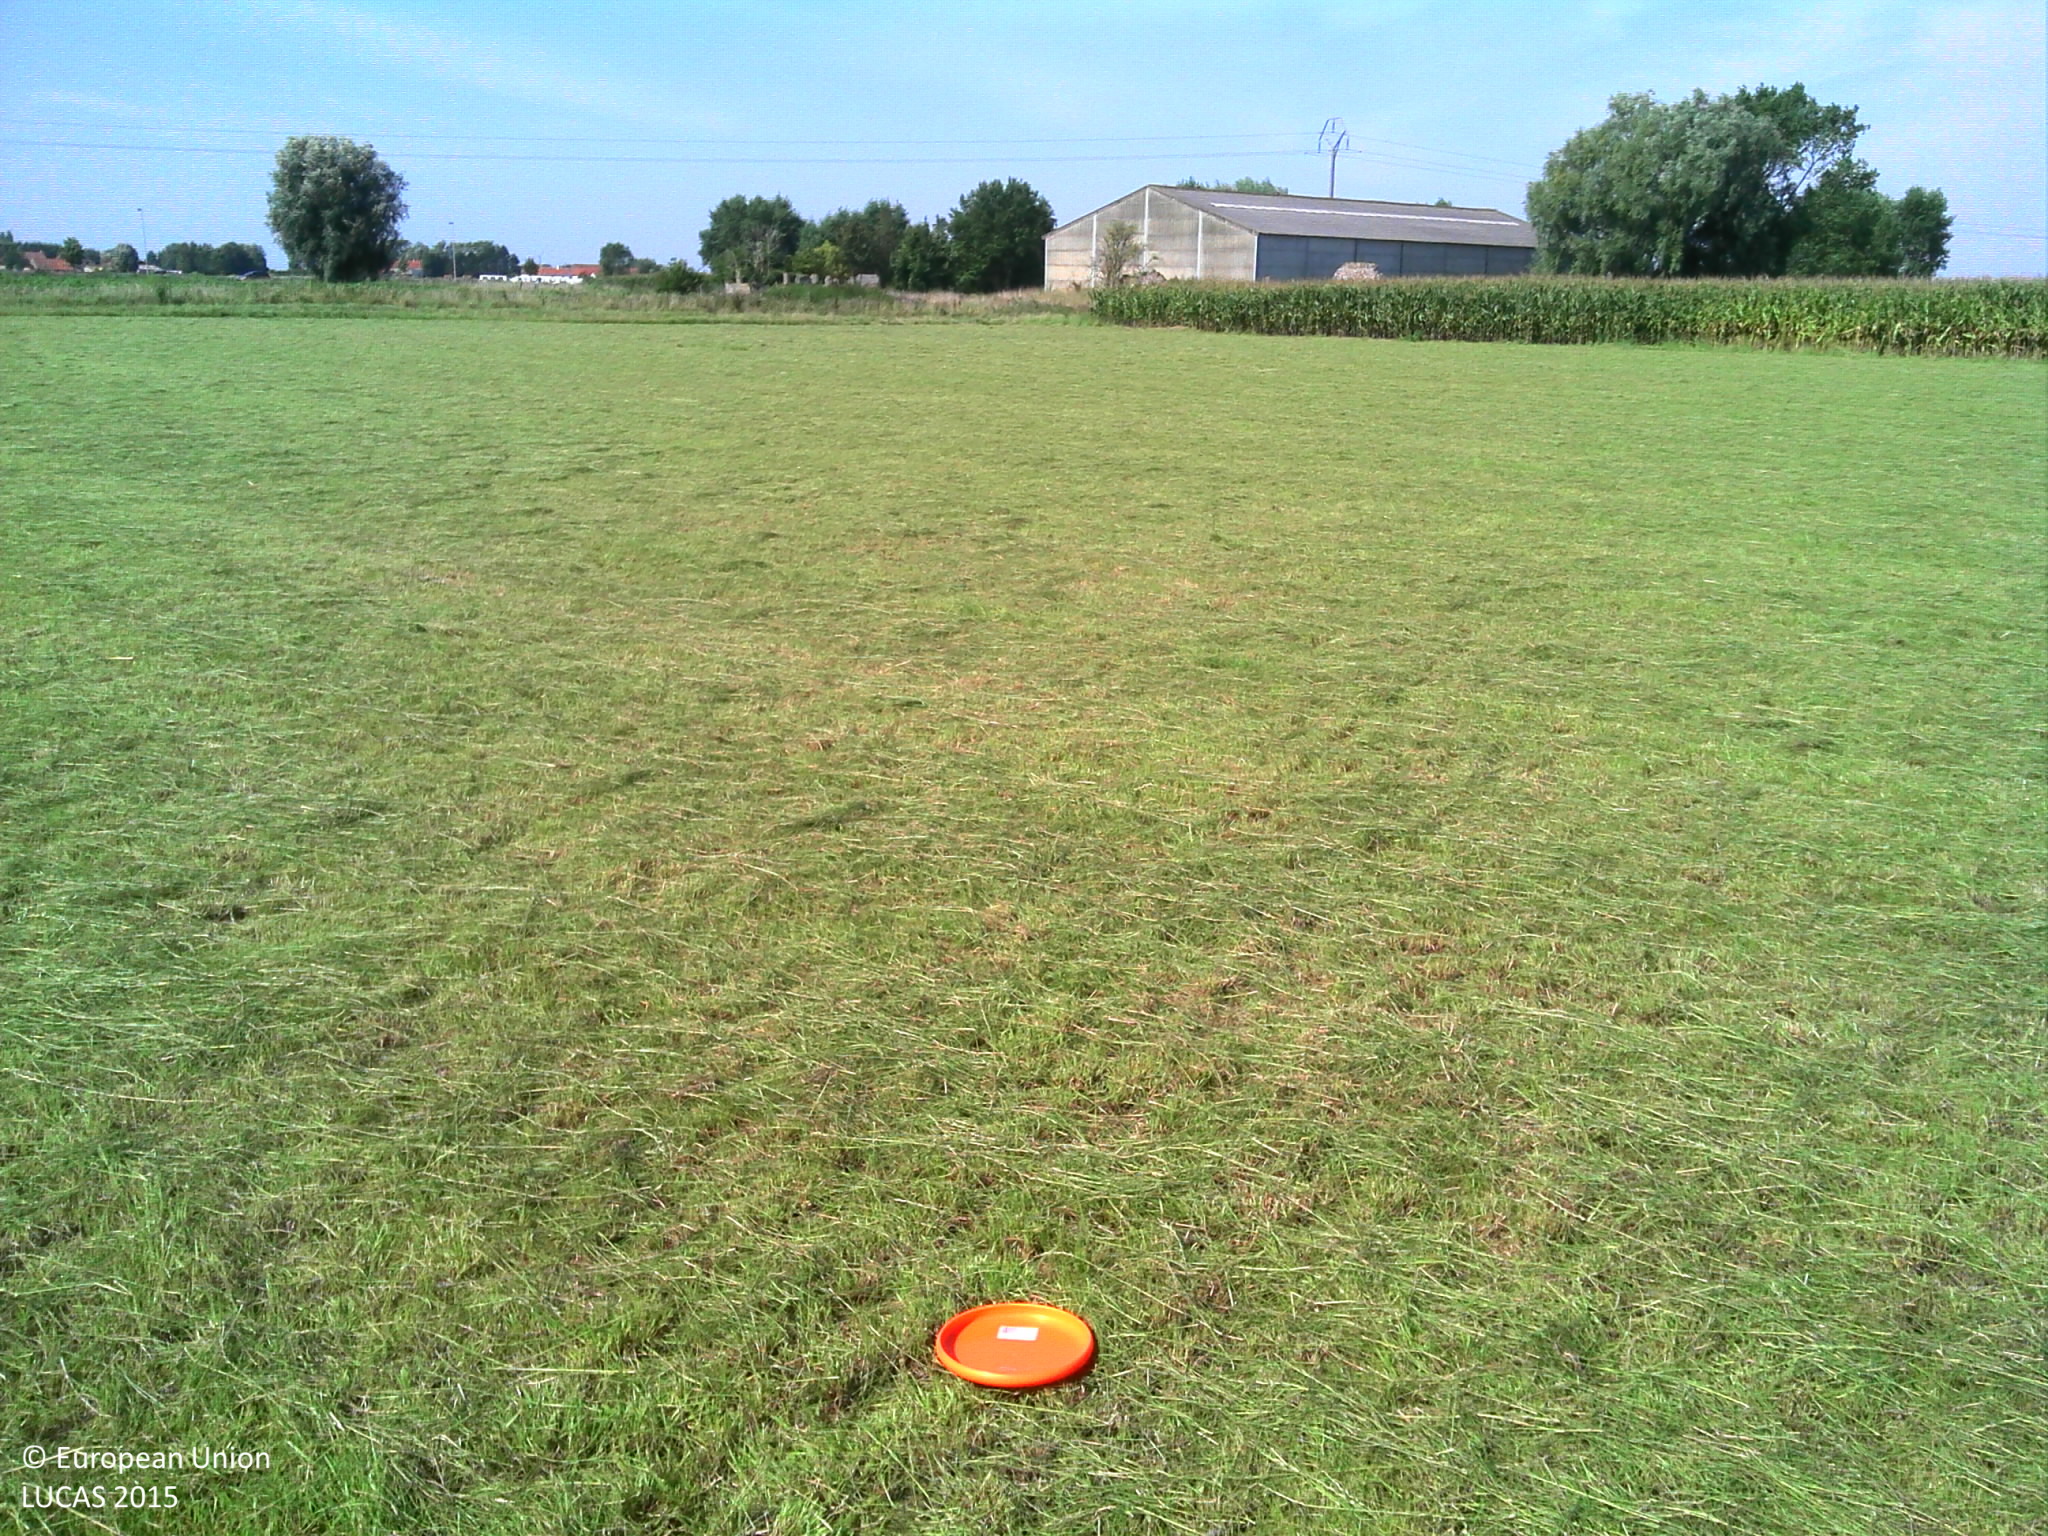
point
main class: Grassland
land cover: Grassland without tree/shrub cover
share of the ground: > 75 %
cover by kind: herbaceous plants 100 %
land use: Agriculture (excluding fallow land and kitchen gardens)
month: September
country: BE
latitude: 51.1762
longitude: 2.9664
